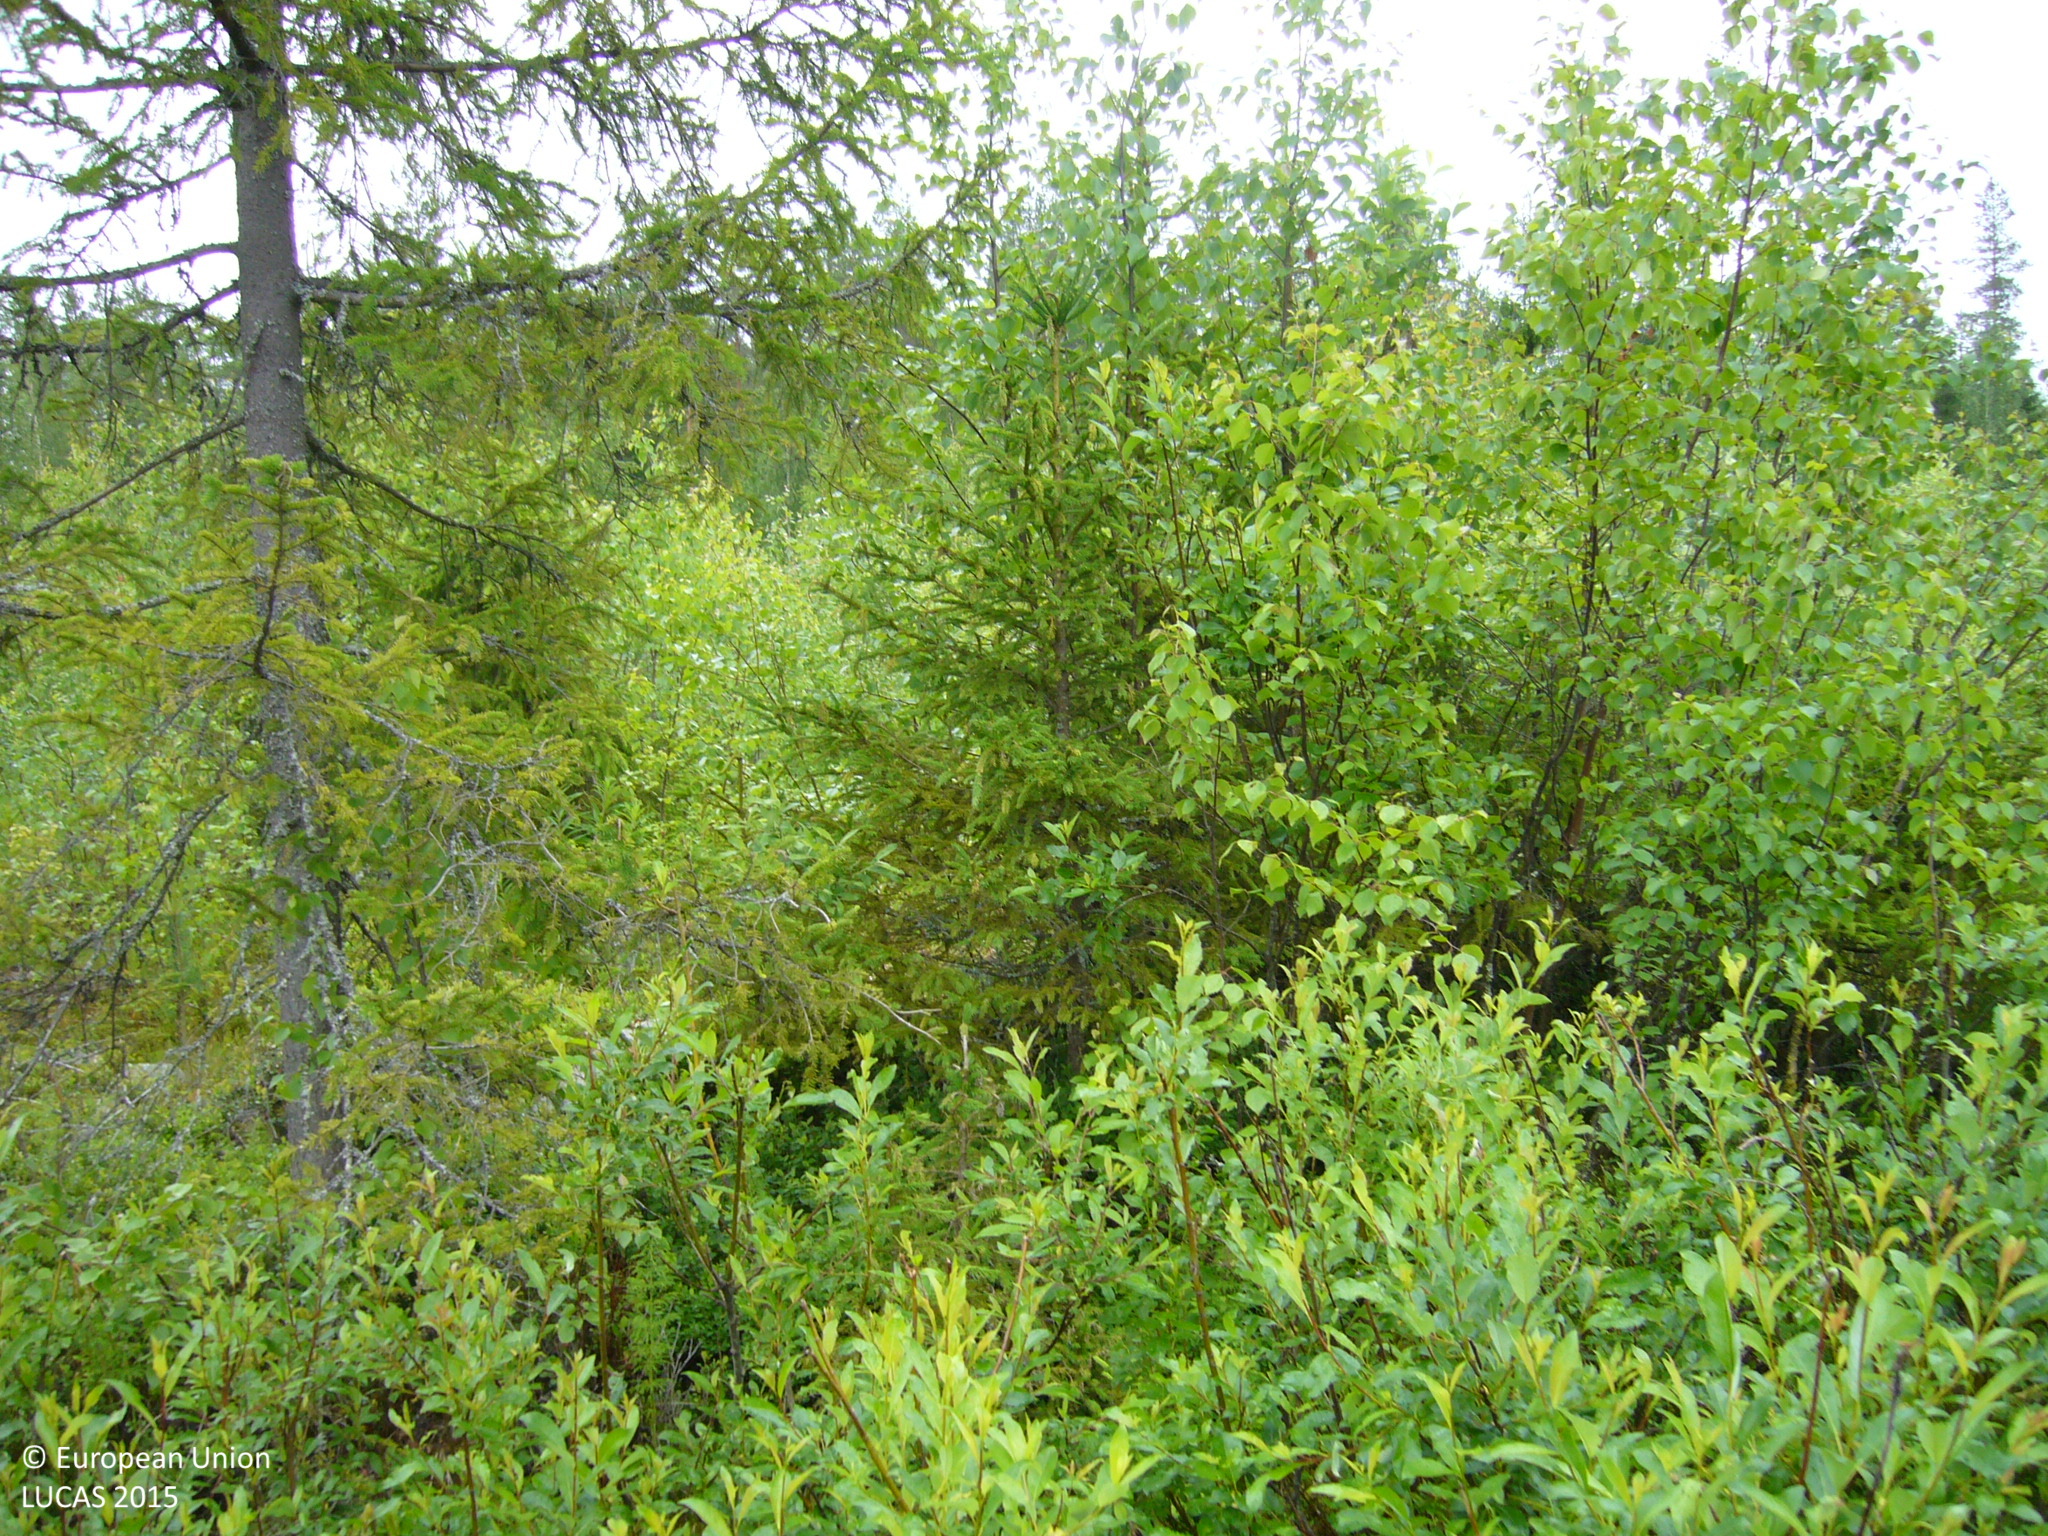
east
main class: Woodland
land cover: Spruce dominated mixed woodland
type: boreal forest
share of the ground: > 75 %
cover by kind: broadleaved forest trees 50 %, coniferous forest trees 25 %, shrubs 25 %
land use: Forestry
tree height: < 5 m
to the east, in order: Spruce dominated mixed woodland; Ditches and canals; Spruce dominated mixed woodland; Ditches and canals; Pine dominated mixed woodland; Ditches and canals; Pine dominated mixed woodland; Ditches and canals; Pine dominated mixed woodland; Ditches and canals; Pine dominated mixed woodland; Ditches and canals; Spruce dominated mixed woodland
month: July
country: FI
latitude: 63.4285
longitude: 25.8400
